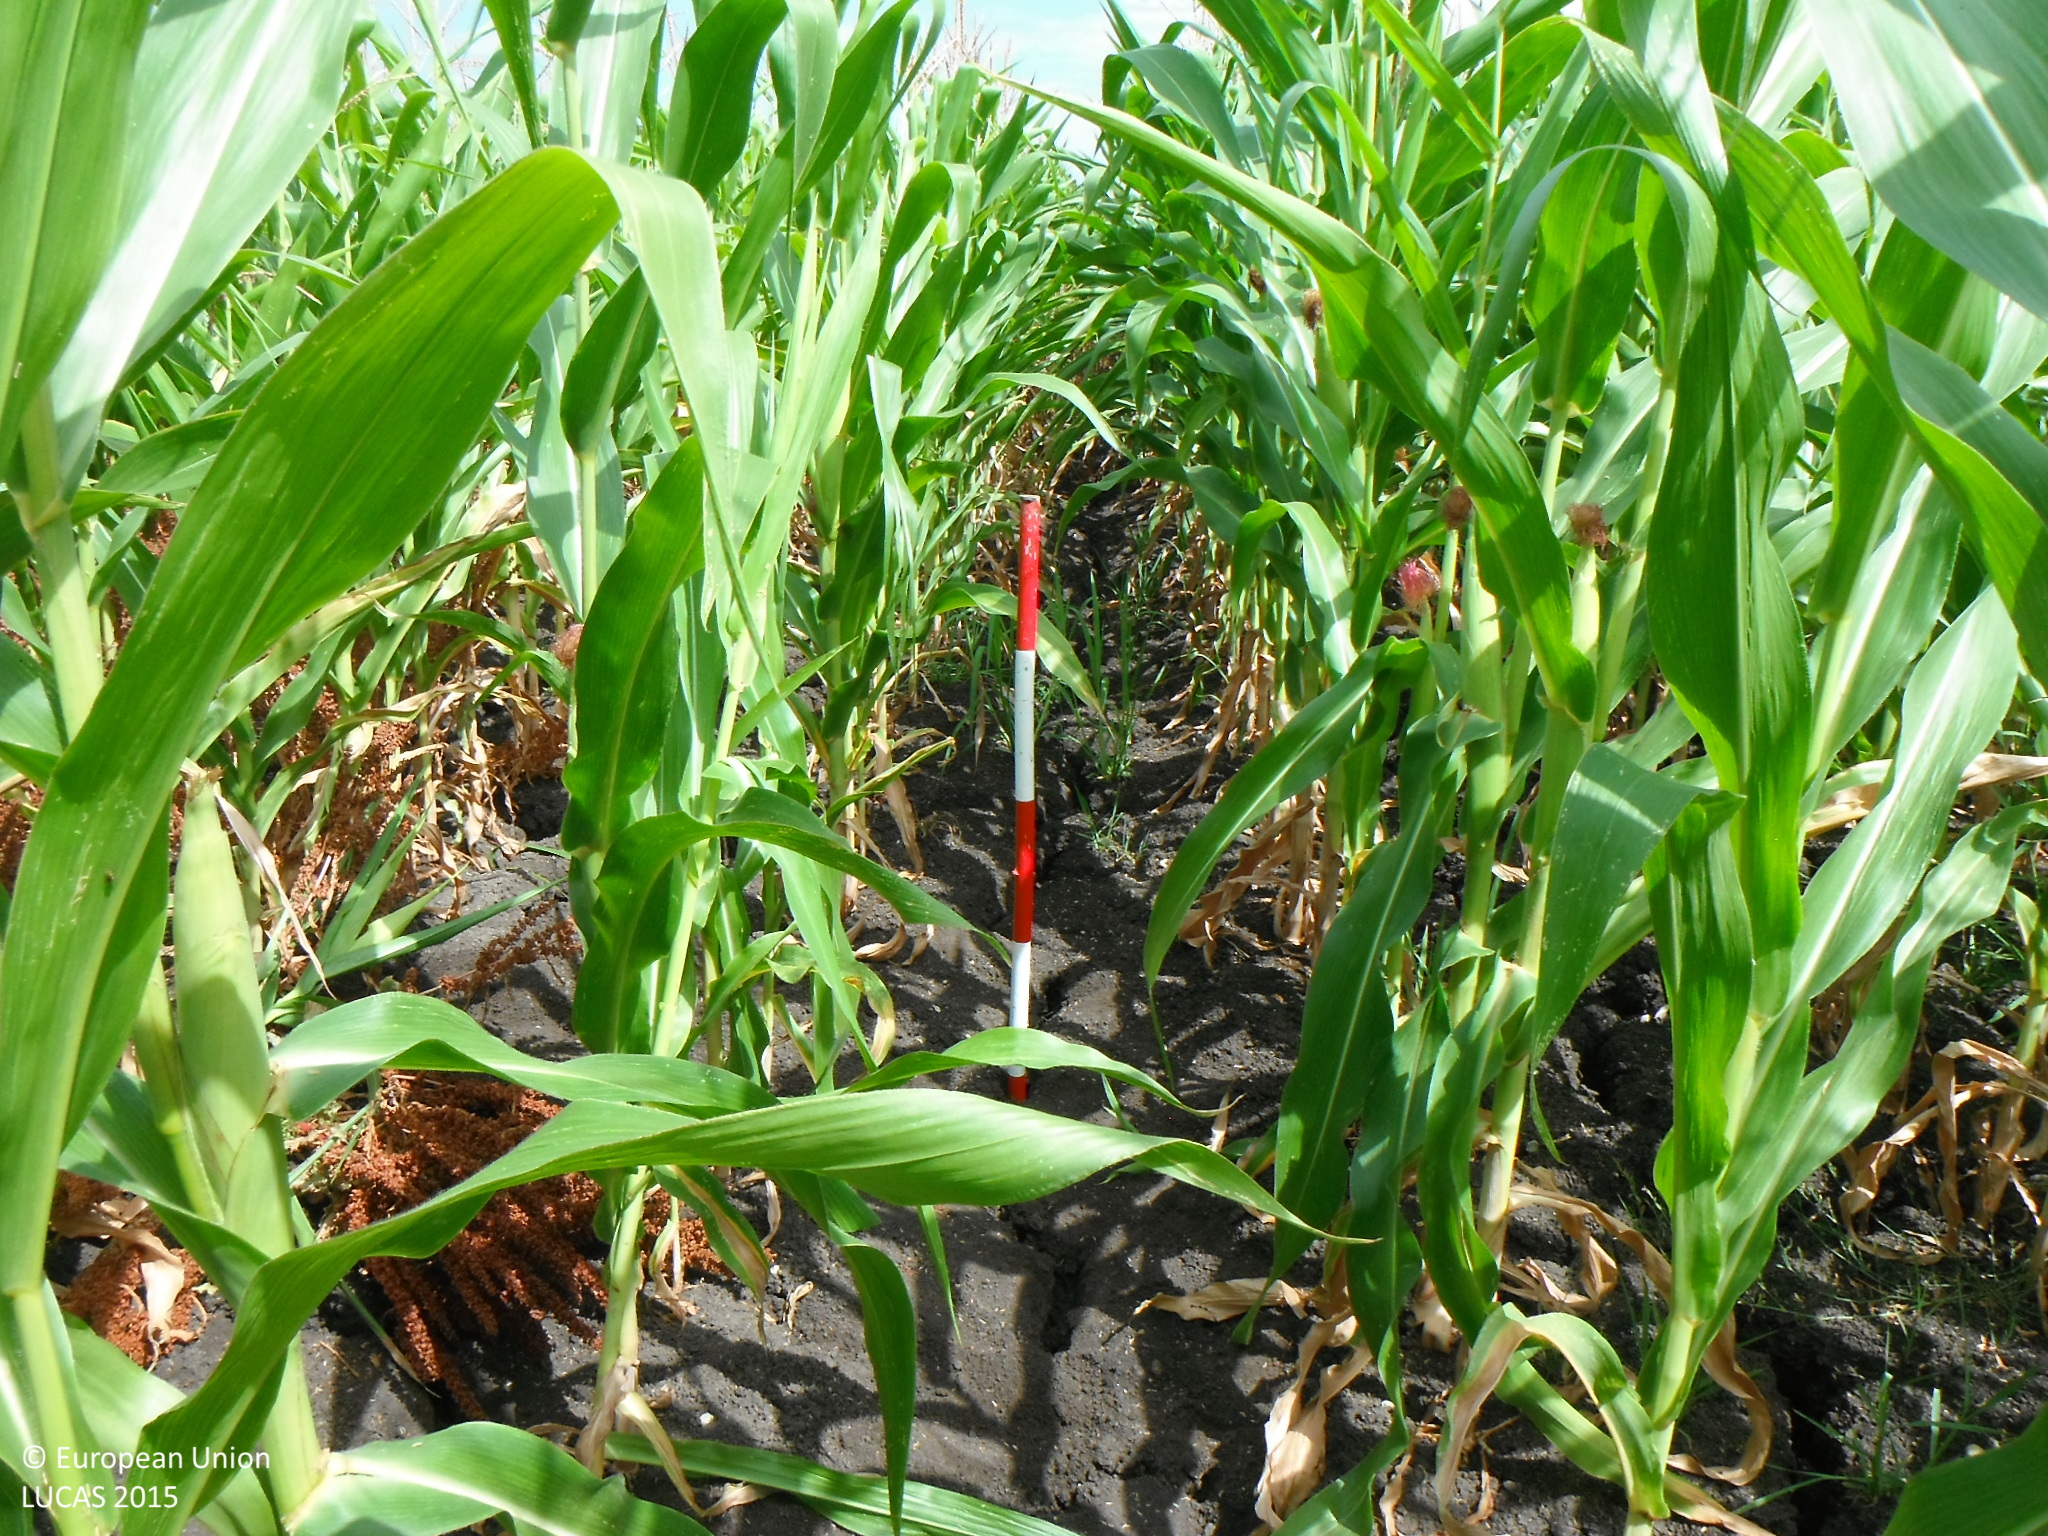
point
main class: Cropland
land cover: Maize
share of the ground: > 75 %
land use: Agriculture (excluding fallow land and kitchen gardens)
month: July
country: SK
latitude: 48.1151
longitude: 18.2212
